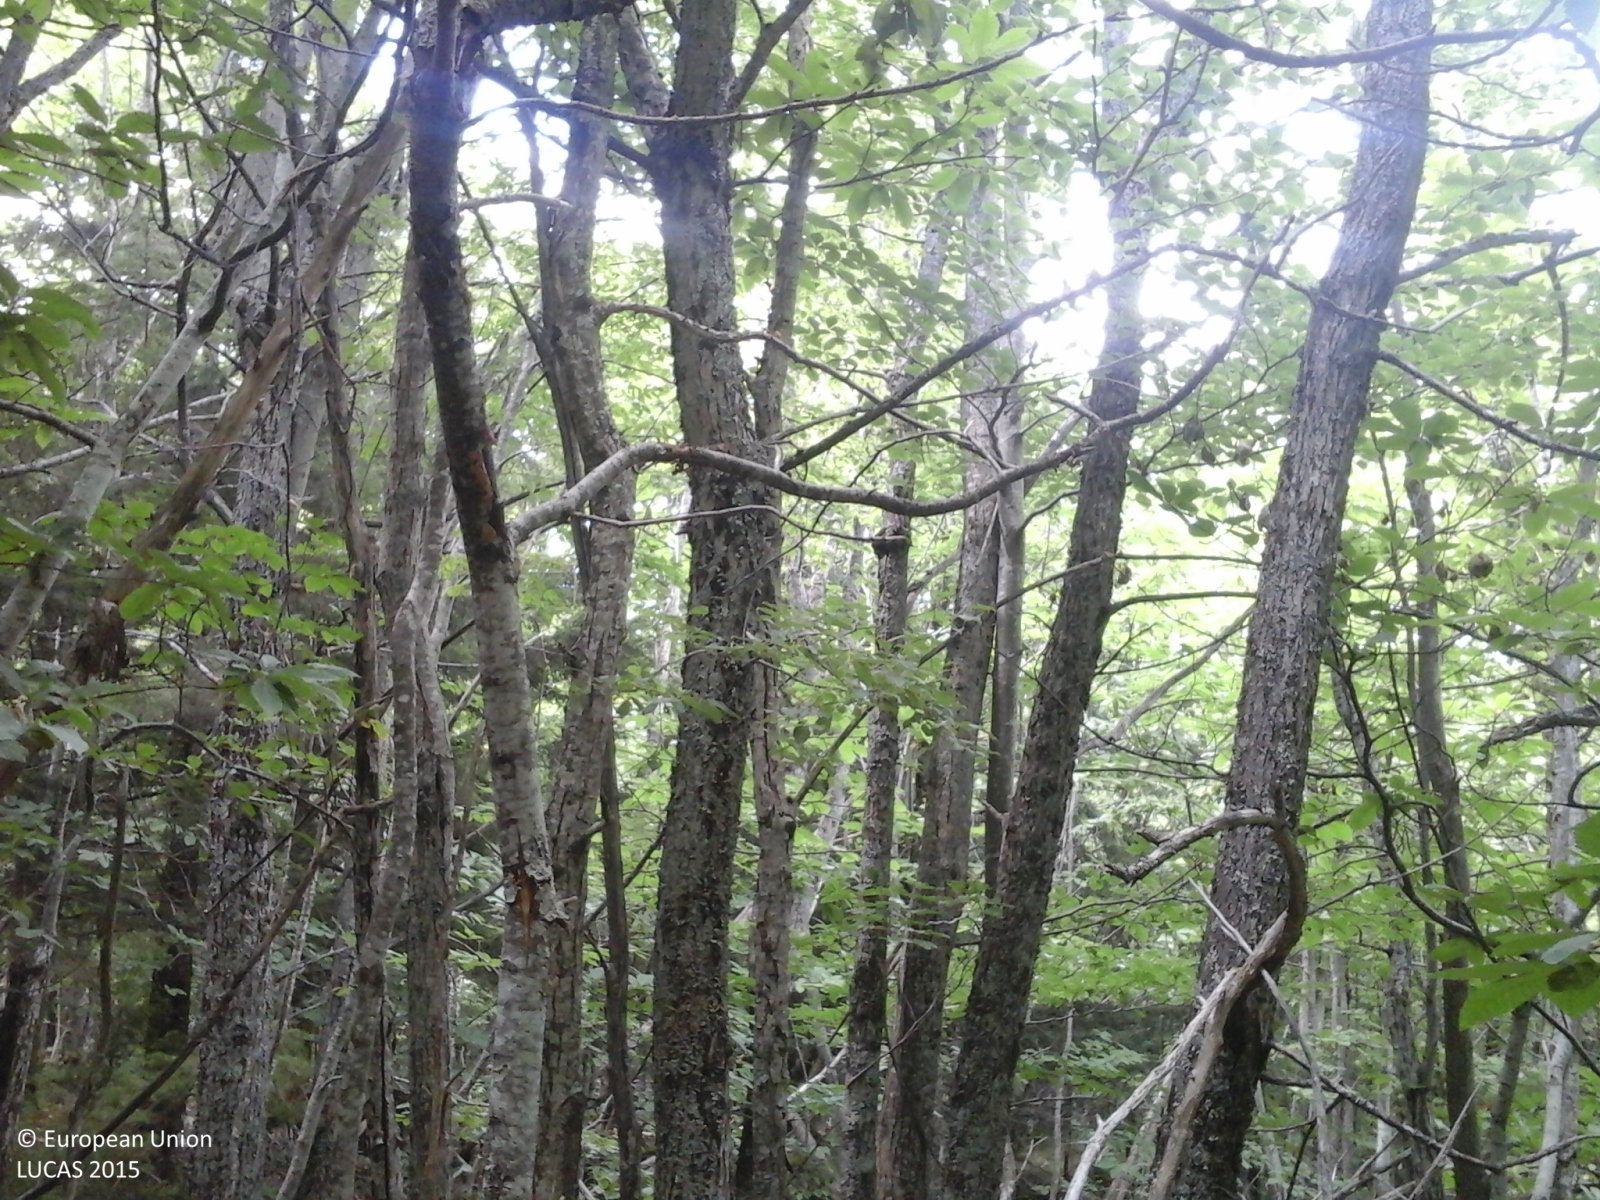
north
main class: Woodland
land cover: Broadleaved woodland
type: thermophilous deciduous forest
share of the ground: > 75 %
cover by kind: broadleaved forest trees 100 %
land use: Forestry
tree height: > 5 m
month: July
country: IT
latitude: 44.1864
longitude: 10.6115
